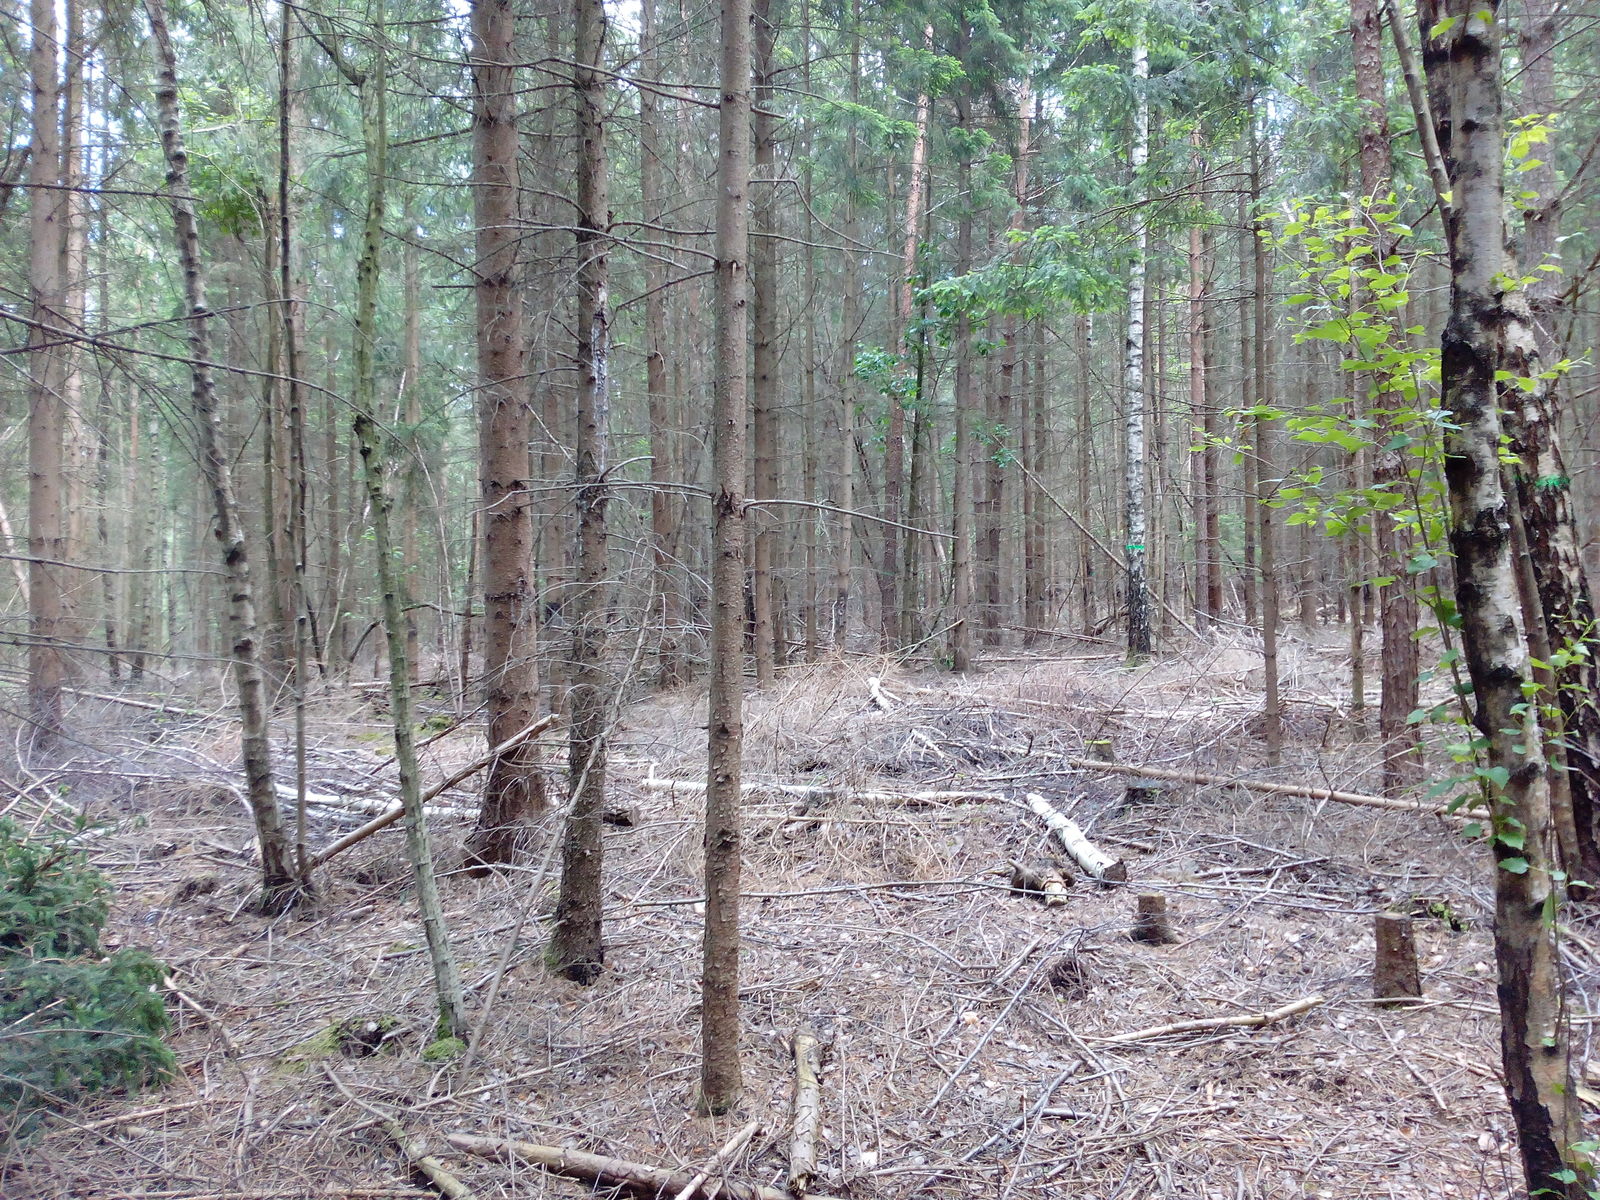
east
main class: Woodland
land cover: Spruce dominated coniferous woodland
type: hemiboreal forest and nemoral coniferous forest and mixed broadleaved-coniferous forest
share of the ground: > 75 %
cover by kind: coniferous forest trees 95 %, broadleaved forest trees 5 %
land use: Forestry
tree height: > 5 m
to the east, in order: Spruce dominated coniferous woodland; Tracks; Spruce dominated coniferous woodland; Broadleaved woodland; Tracks; Broadleaved woodland
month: June
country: DE
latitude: 50.7566
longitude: 10.8361
